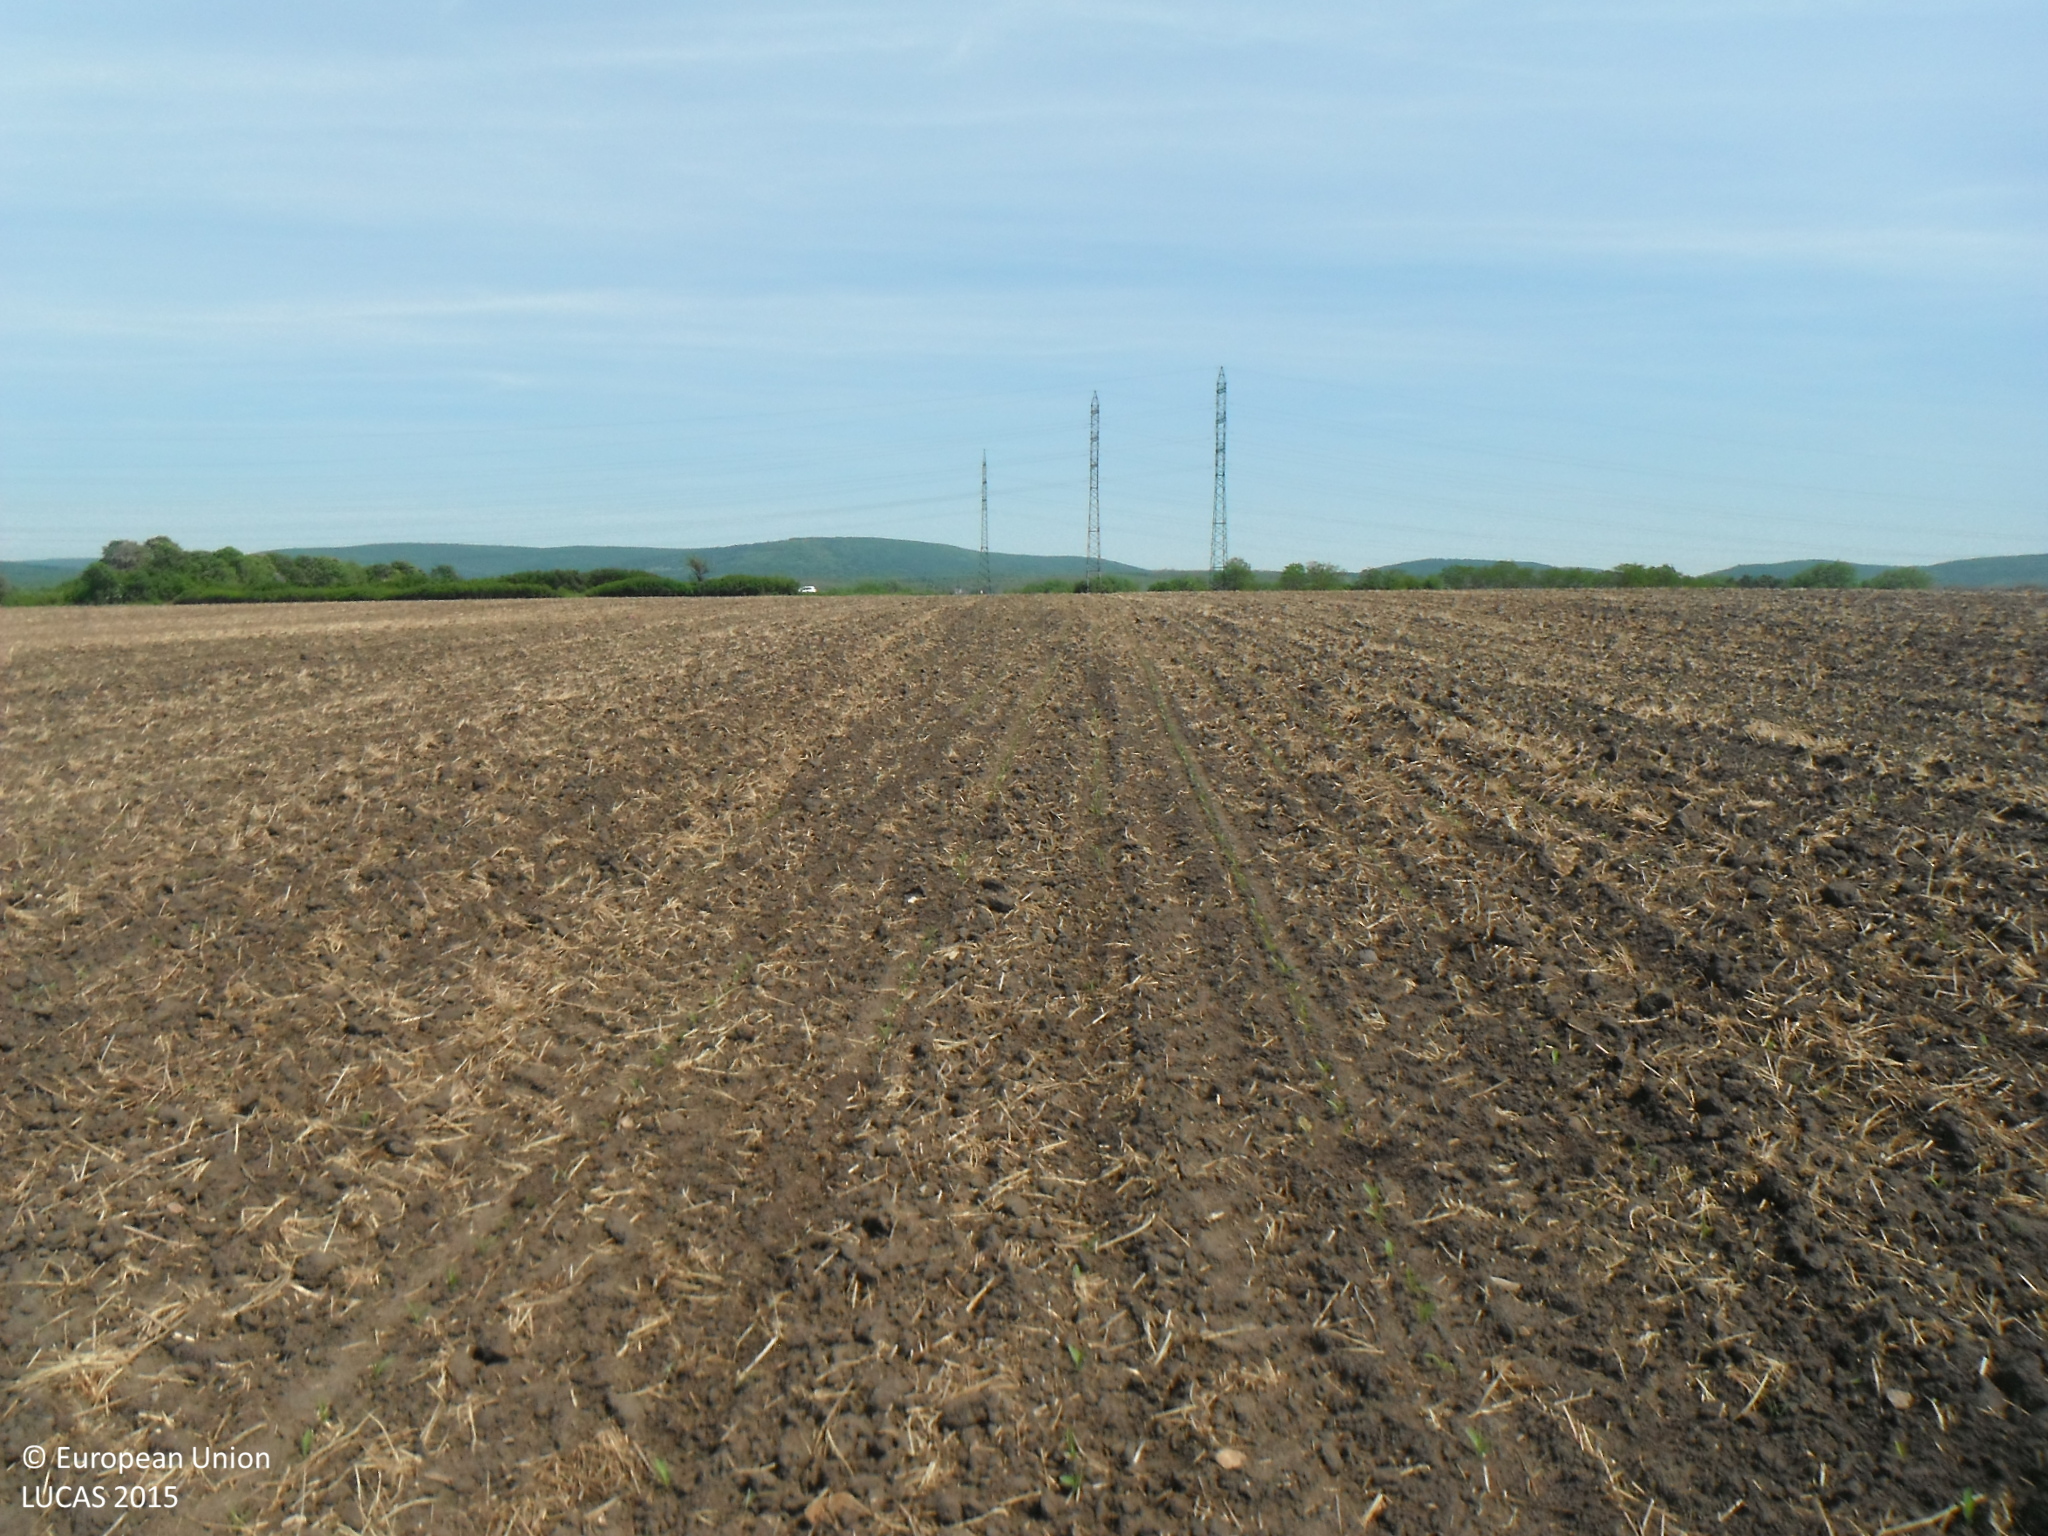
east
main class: Cropland
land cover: Maize
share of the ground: < 10 %
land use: Agriculture (excluding fallow land and kitchen gardens)
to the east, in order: Maize; Electric lines; Maize; Electric lines; Maize
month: May
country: SK
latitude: 48.2718
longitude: 17.0004
